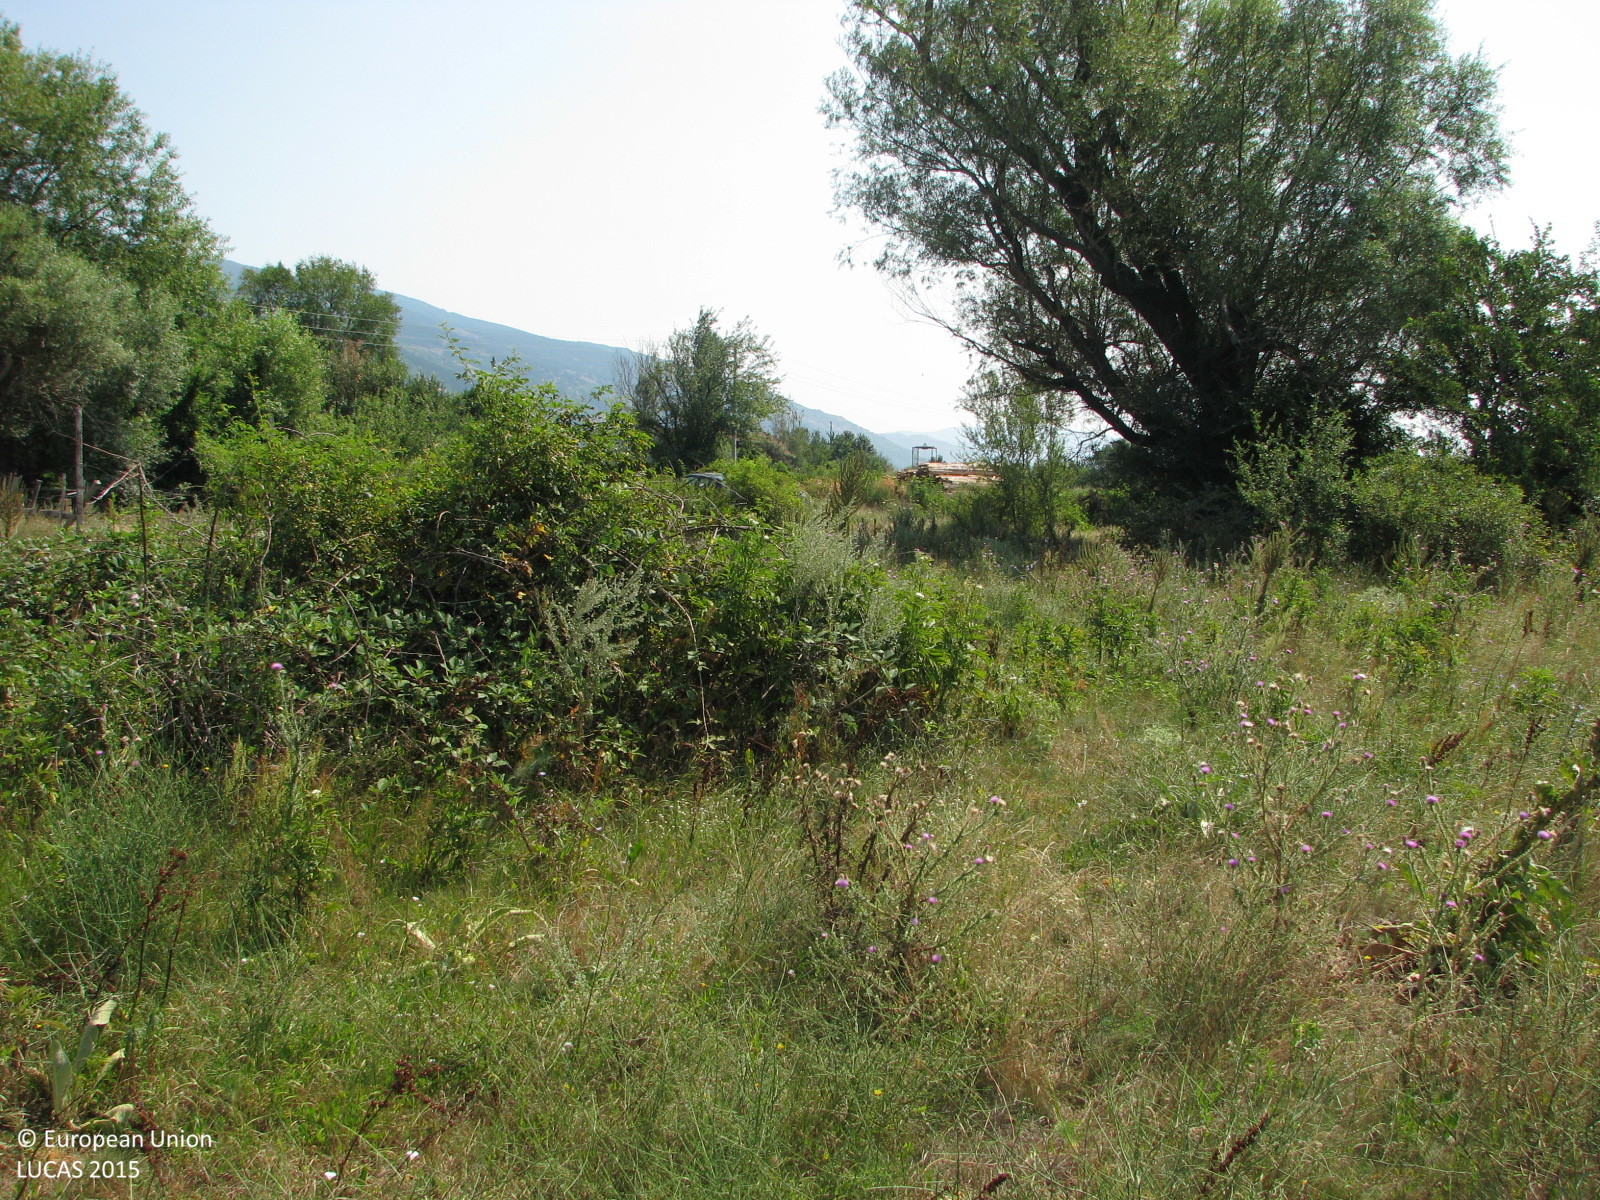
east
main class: Grassland
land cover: Grassland with sparse tree/shrub cover
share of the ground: > 75 %
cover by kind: herbaceous plants 90 %, broadleaved forest trees 5 %, shrubs 5 %
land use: Abandoned areas
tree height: < 5 m
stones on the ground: < 10 %
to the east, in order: Grassland with sparse tree/shrub cover; Tracks; Rivers and streams; Tracks; Grass margins; Ditches and canals; Grass margins; Lucerne; Grassland without tree/shrub cover; Tracks; Grassland without tree/shrub cover; Single bushes/trees; Grassland without tree/shrub cover; Cherry fruit
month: July
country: BG
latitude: 42.6871
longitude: 25.9360
